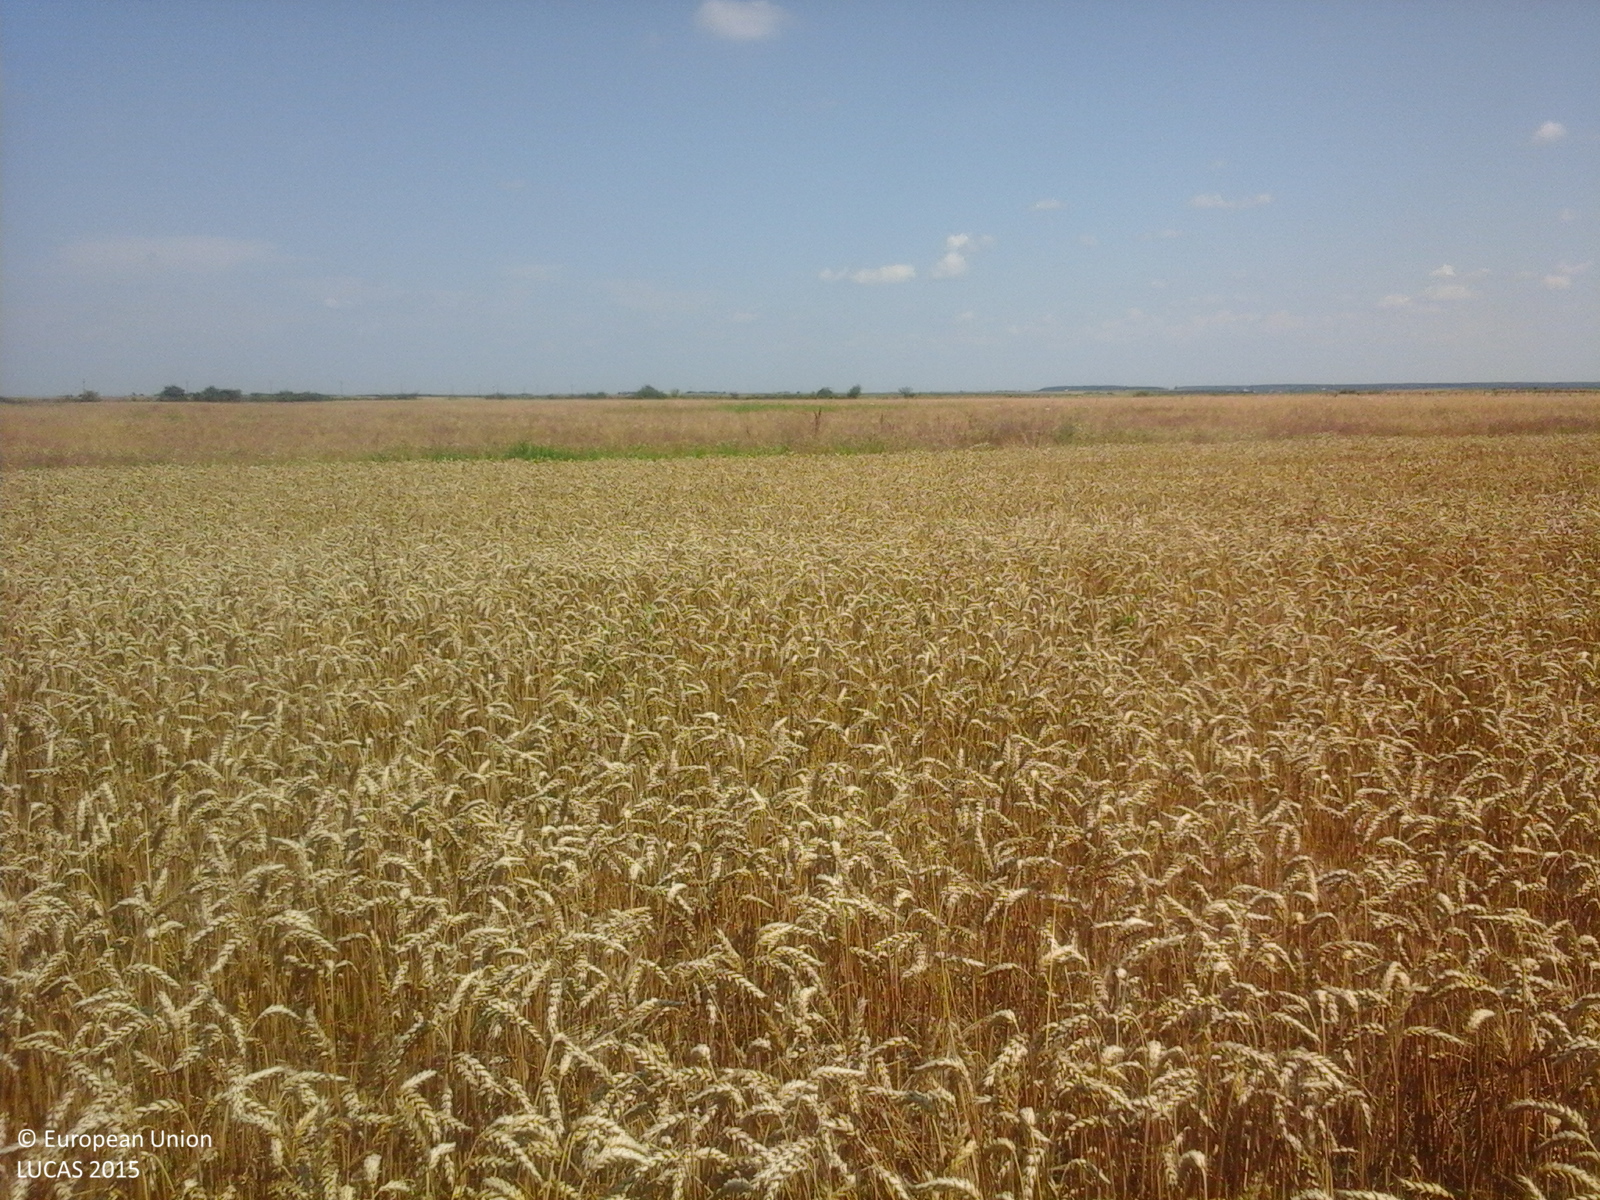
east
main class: Cropland
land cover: Common wheat
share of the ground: > 75 %
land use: Agriculture (excluding fallow land and kitchen gardens)
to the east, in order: Common wheat; Grass margins; Tracks; Grass margins; Mixed cereals for fodder
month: July
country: RO
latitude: 44.2670
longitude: 24.1812
